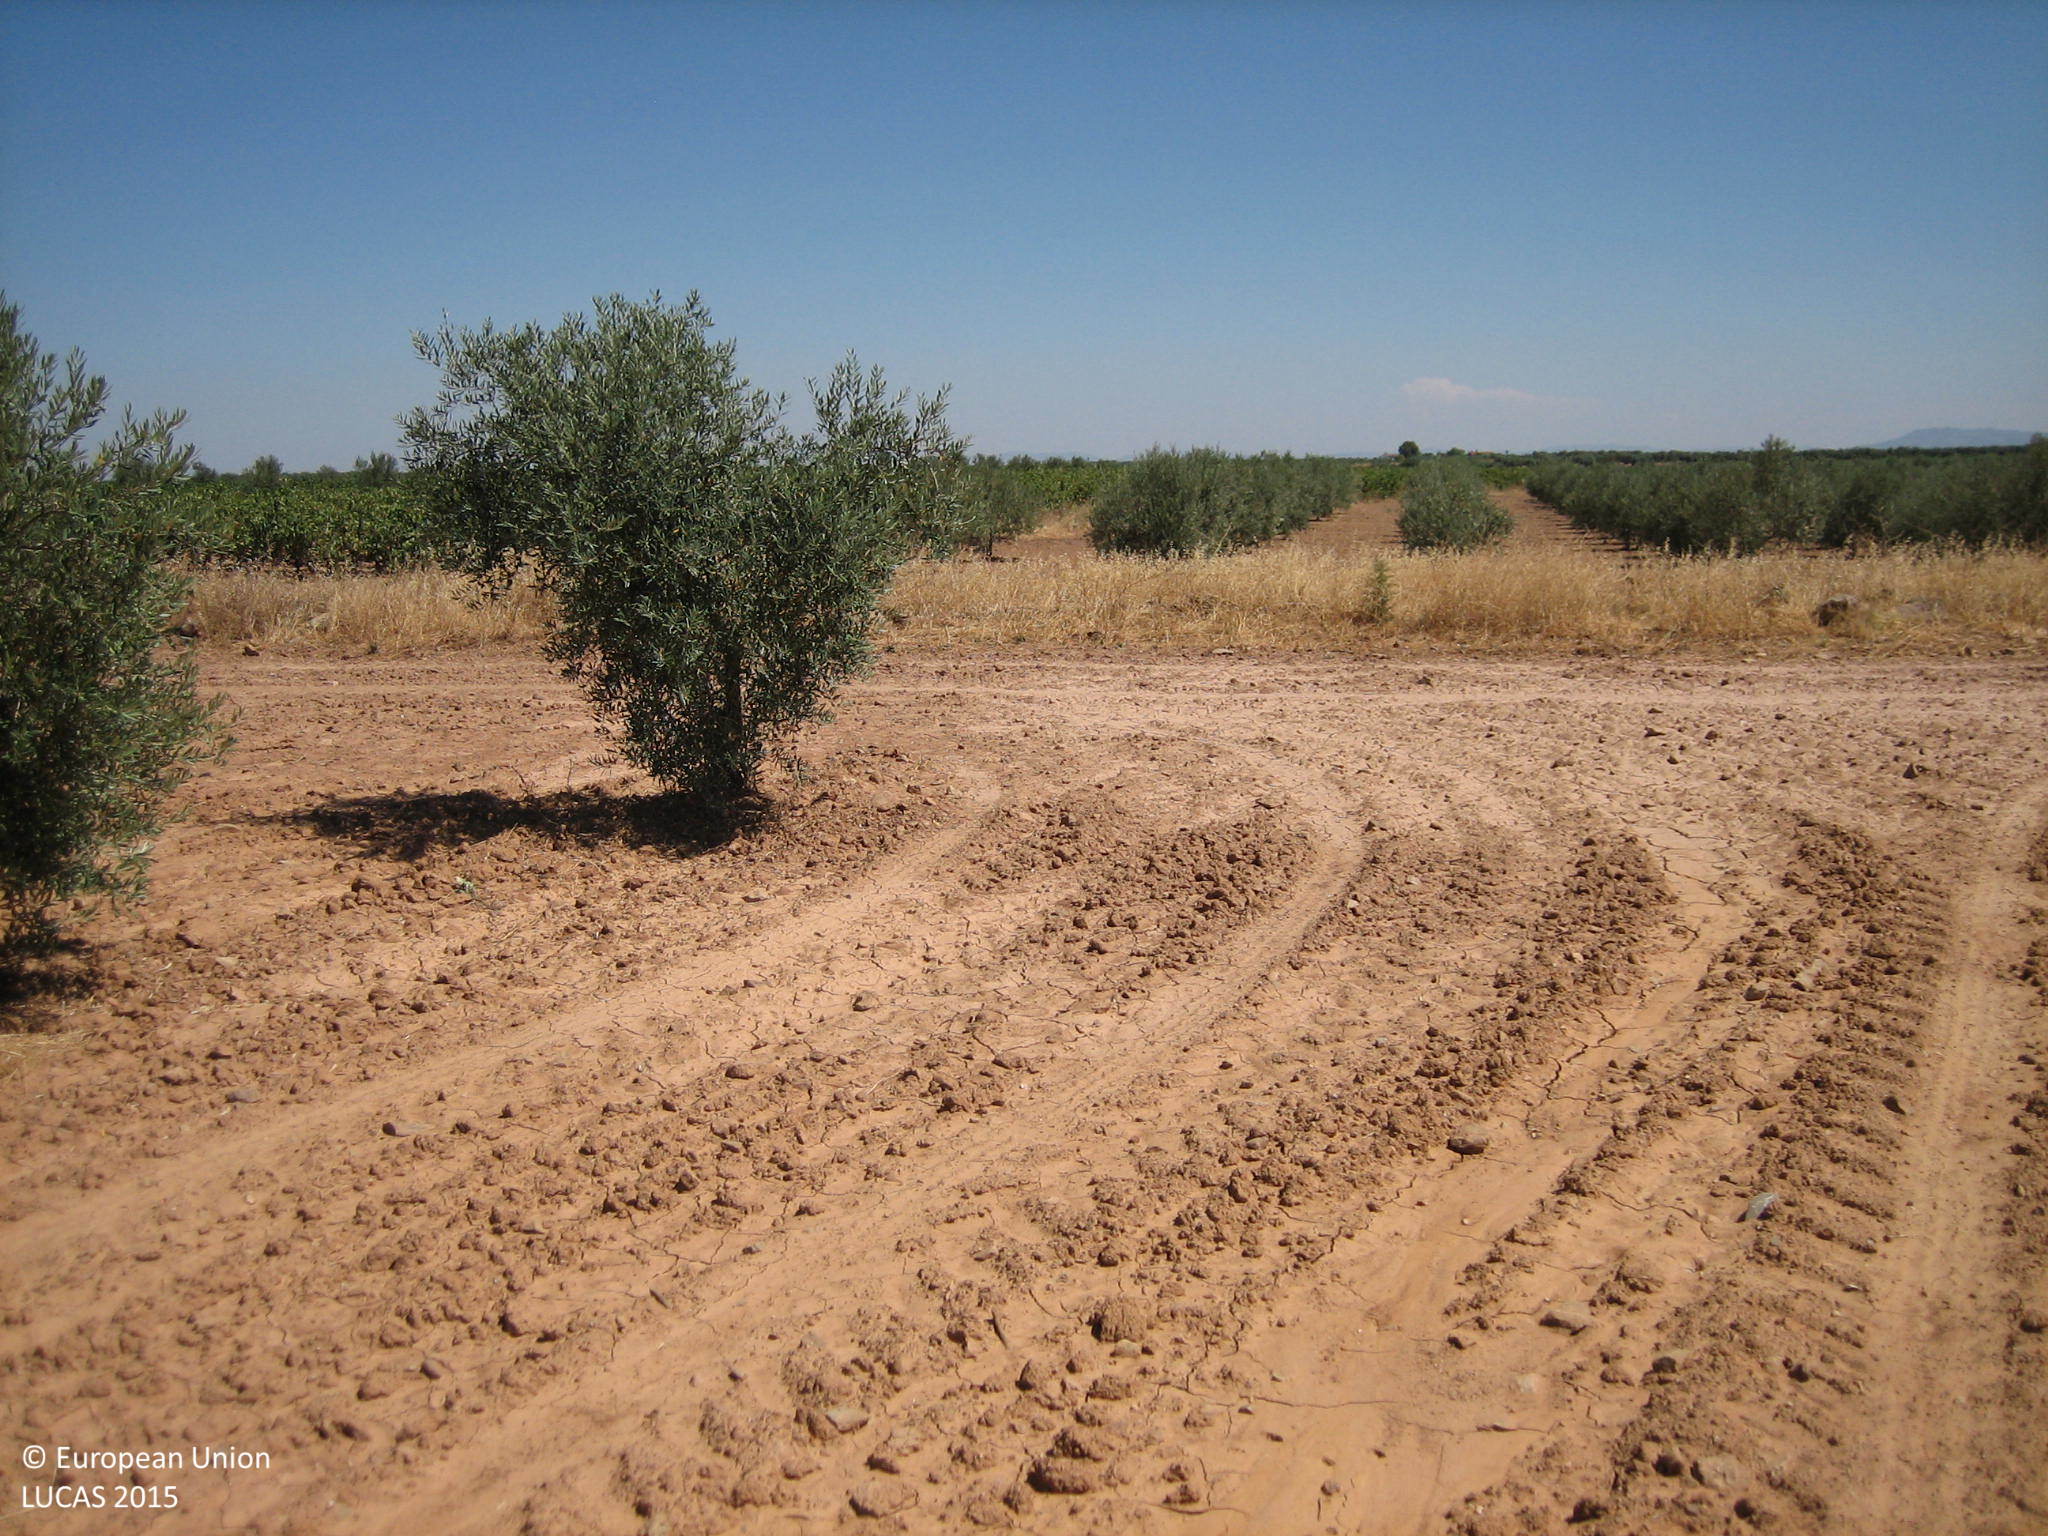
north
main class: Cropland
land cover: Olive groves
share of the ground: 25 - 50 %
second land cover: Other bare soil
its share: > 75 %
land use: Agriculture (excluding fallow land and kitchen gardens)
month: July
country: ES
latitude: 38.4287
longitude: -6.3264
